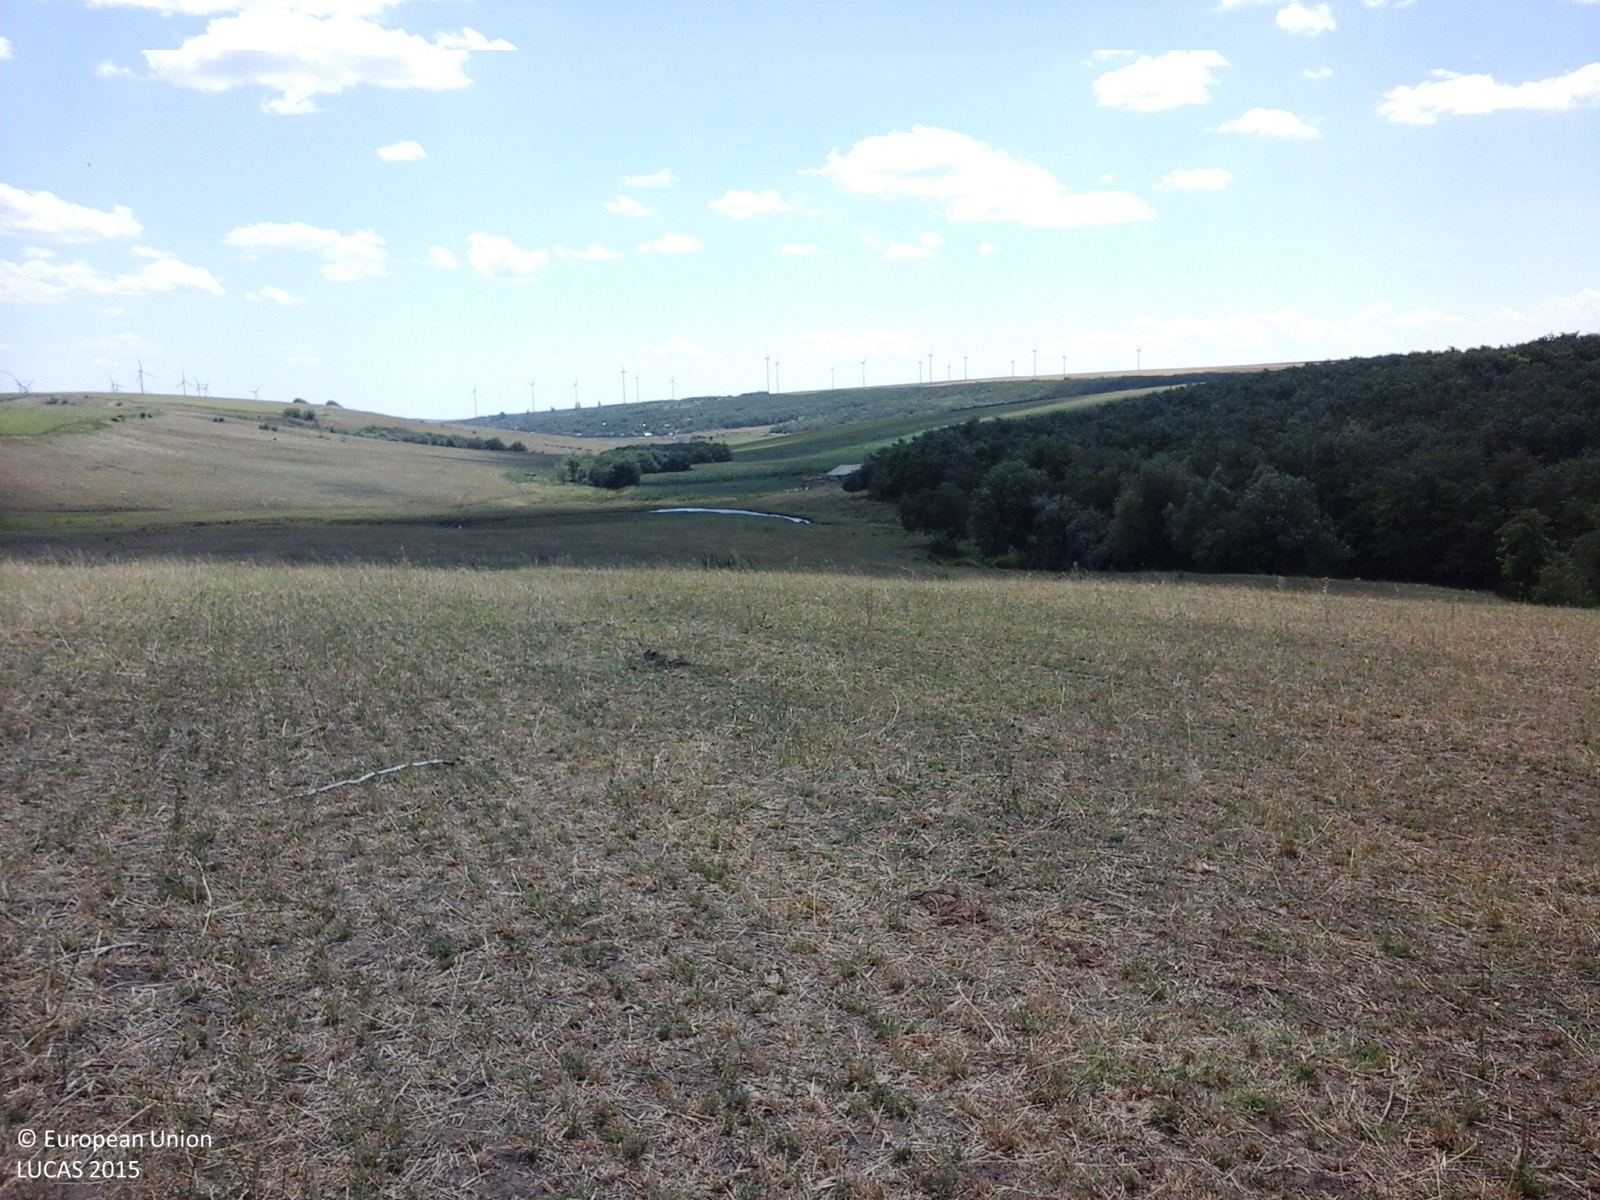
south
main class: Grassland
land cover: Grassland without tree/shrub cover
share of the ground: > 75 %
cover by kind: herbaceous plants 100 %
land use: Agriculture (excluding fallow land and kitchen gardens)
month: July
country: RO
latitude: 45.8825
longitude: 27.7532
